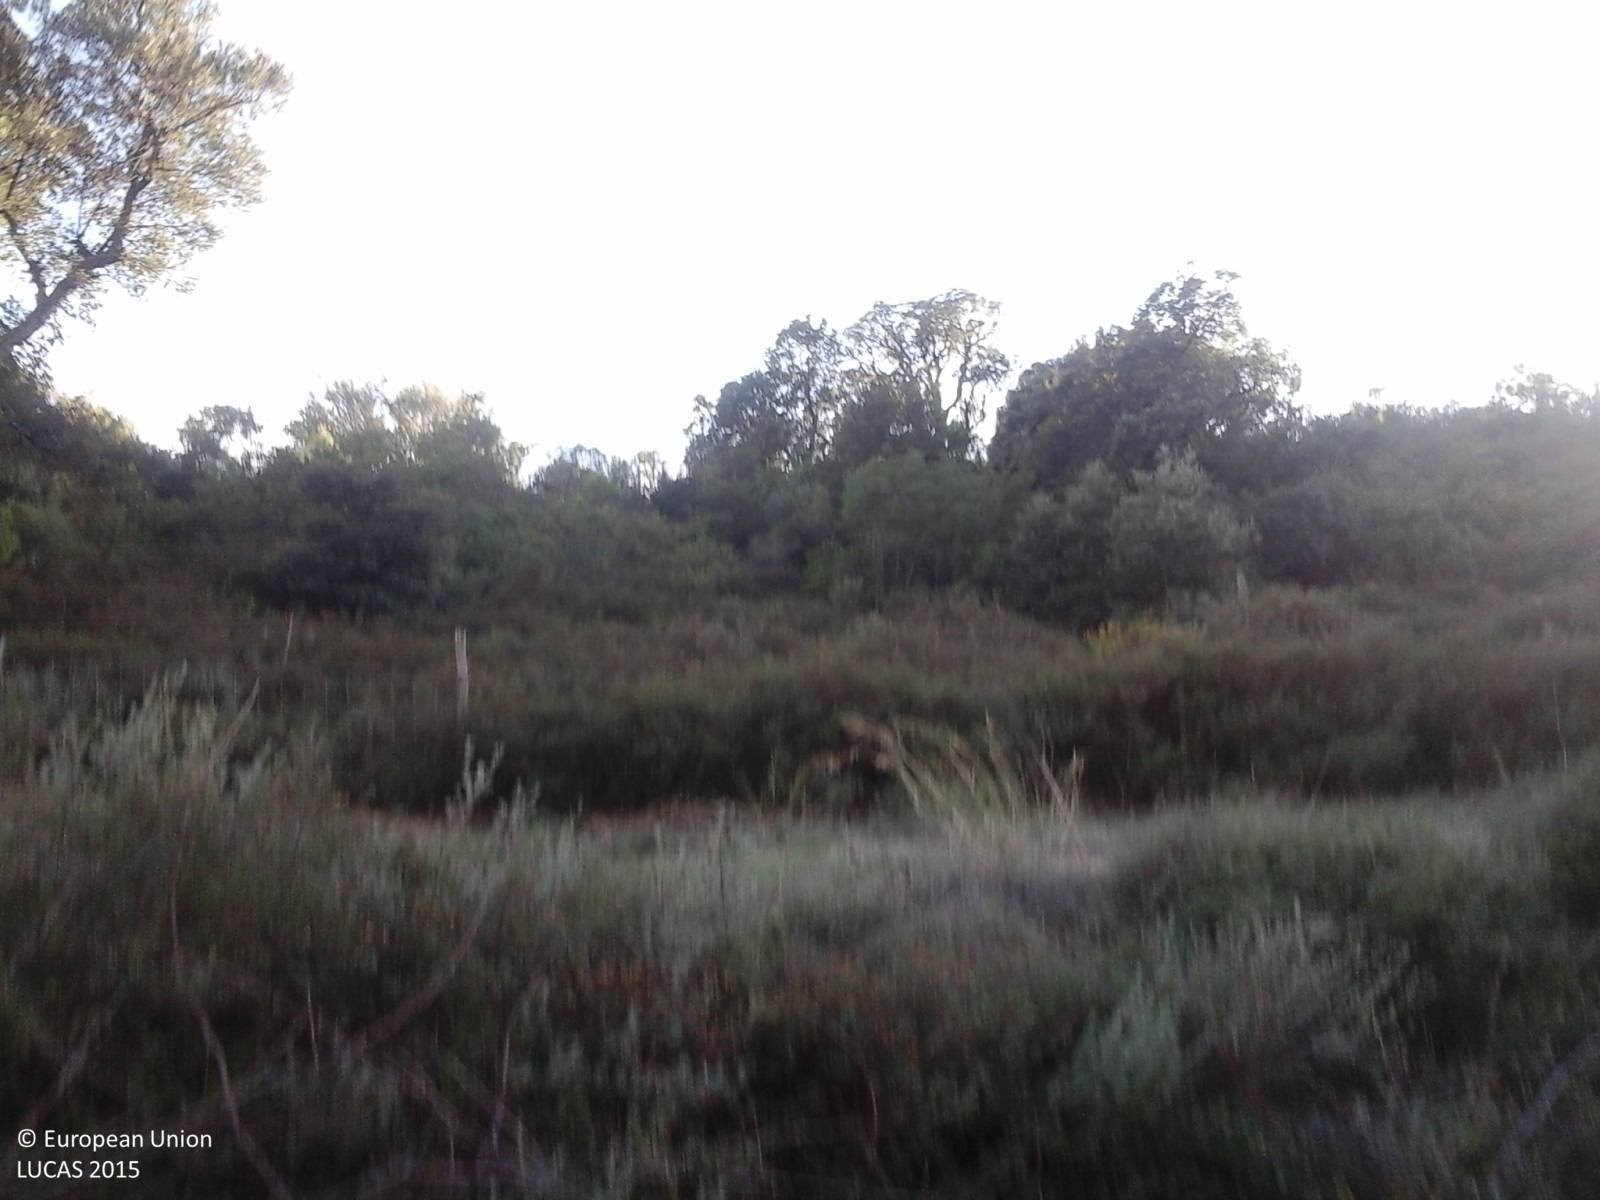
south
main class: Woodland
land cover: Broadleaved woodland
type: broadleaved evergreen forest
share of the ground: > 75 %
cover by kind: broadleaved forest trees 80 %, shrubs 20 %
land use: Forestry
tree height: < 5 m
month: October
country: IT
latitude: 40.1546
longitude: 9.1008
